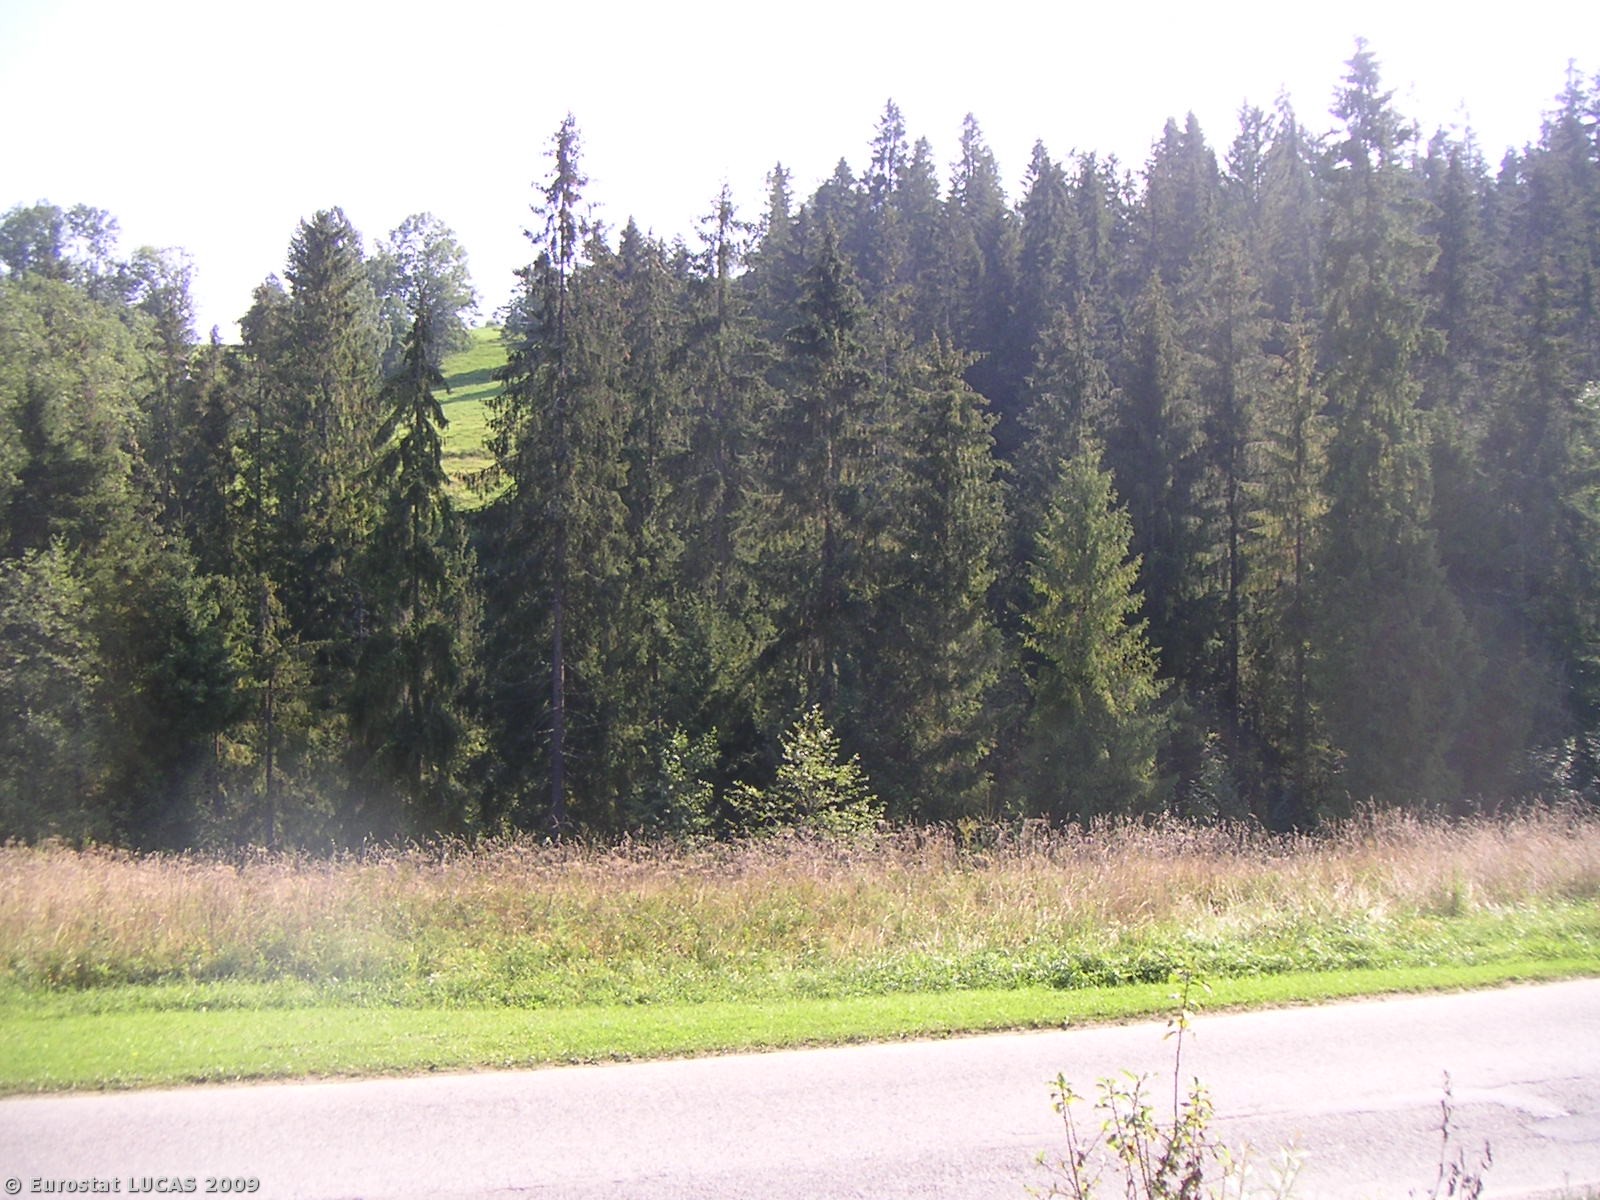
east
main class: Grassland
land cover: Grassland without tree/shrub cover
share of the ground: > 75 %
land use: Agriculture (excluding fallow land and kitchen gardens)
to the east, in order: Grassland without tree/shrub cover; Paved roads, cycling and walking lanes; Grassland without tree/shrub cover; Mixed woodland; Grassland without tree/shrub cover; Grassland with sparse tree/shrub cover
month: September
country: PL
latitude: 49.3568
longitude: 20.0687
